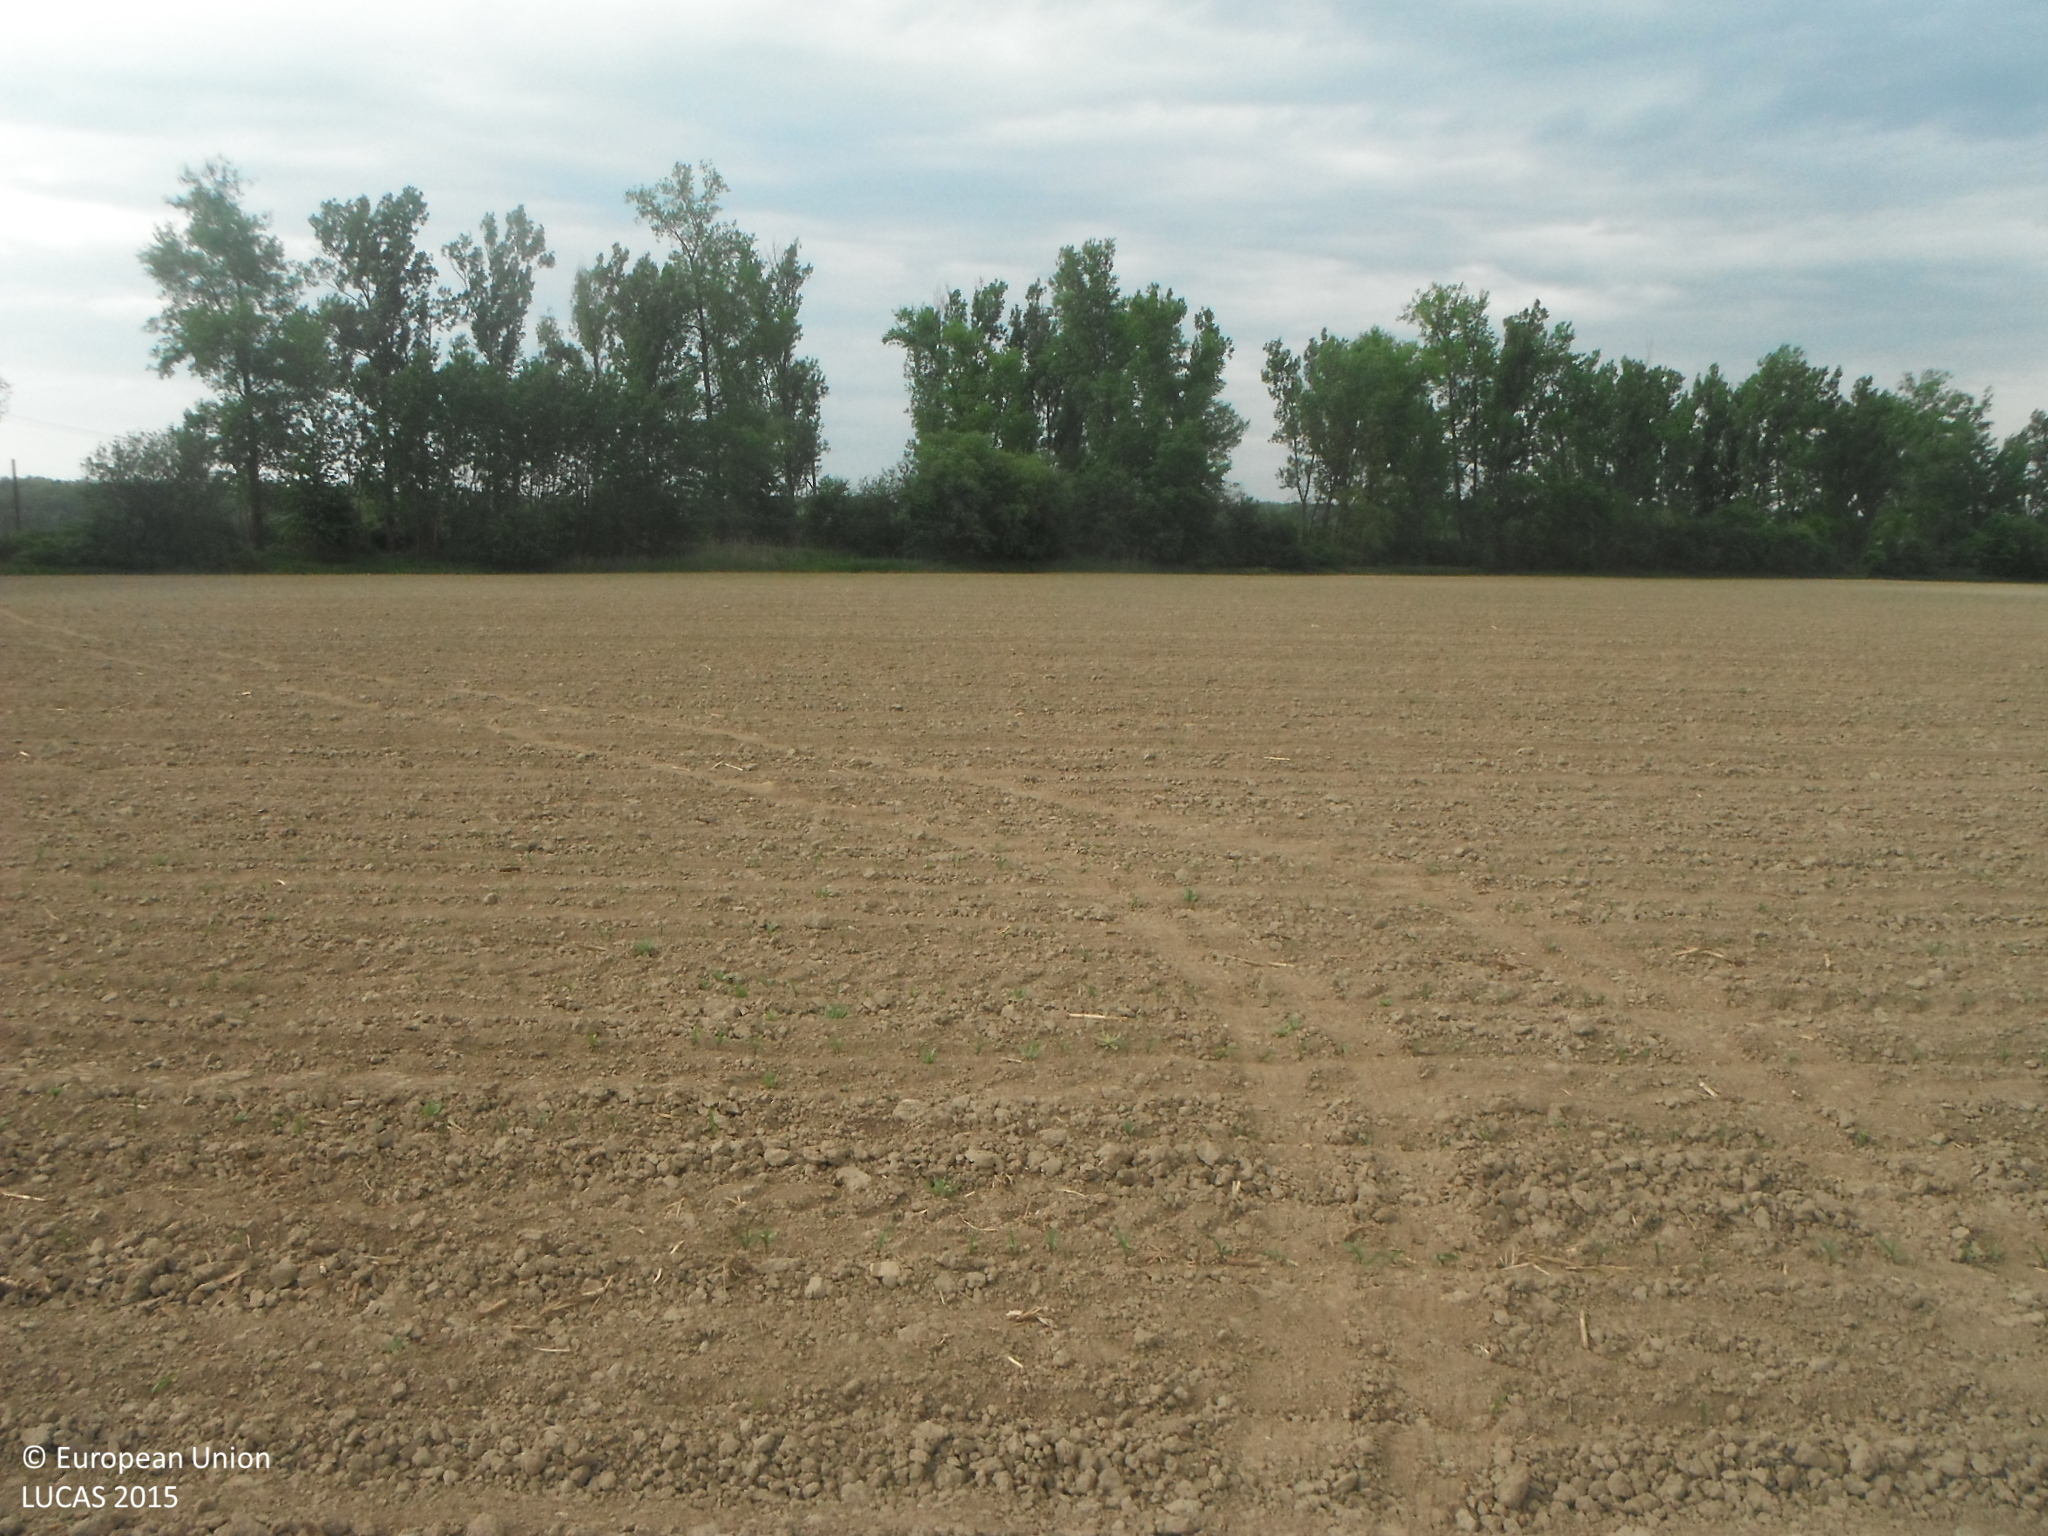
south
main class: Cropland
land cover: Maize
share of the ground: < 10 %
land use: Agriculture (excluding fallow land and kitchen gardens)
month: May
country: SK
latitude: 48.5634
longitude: 20.9759
